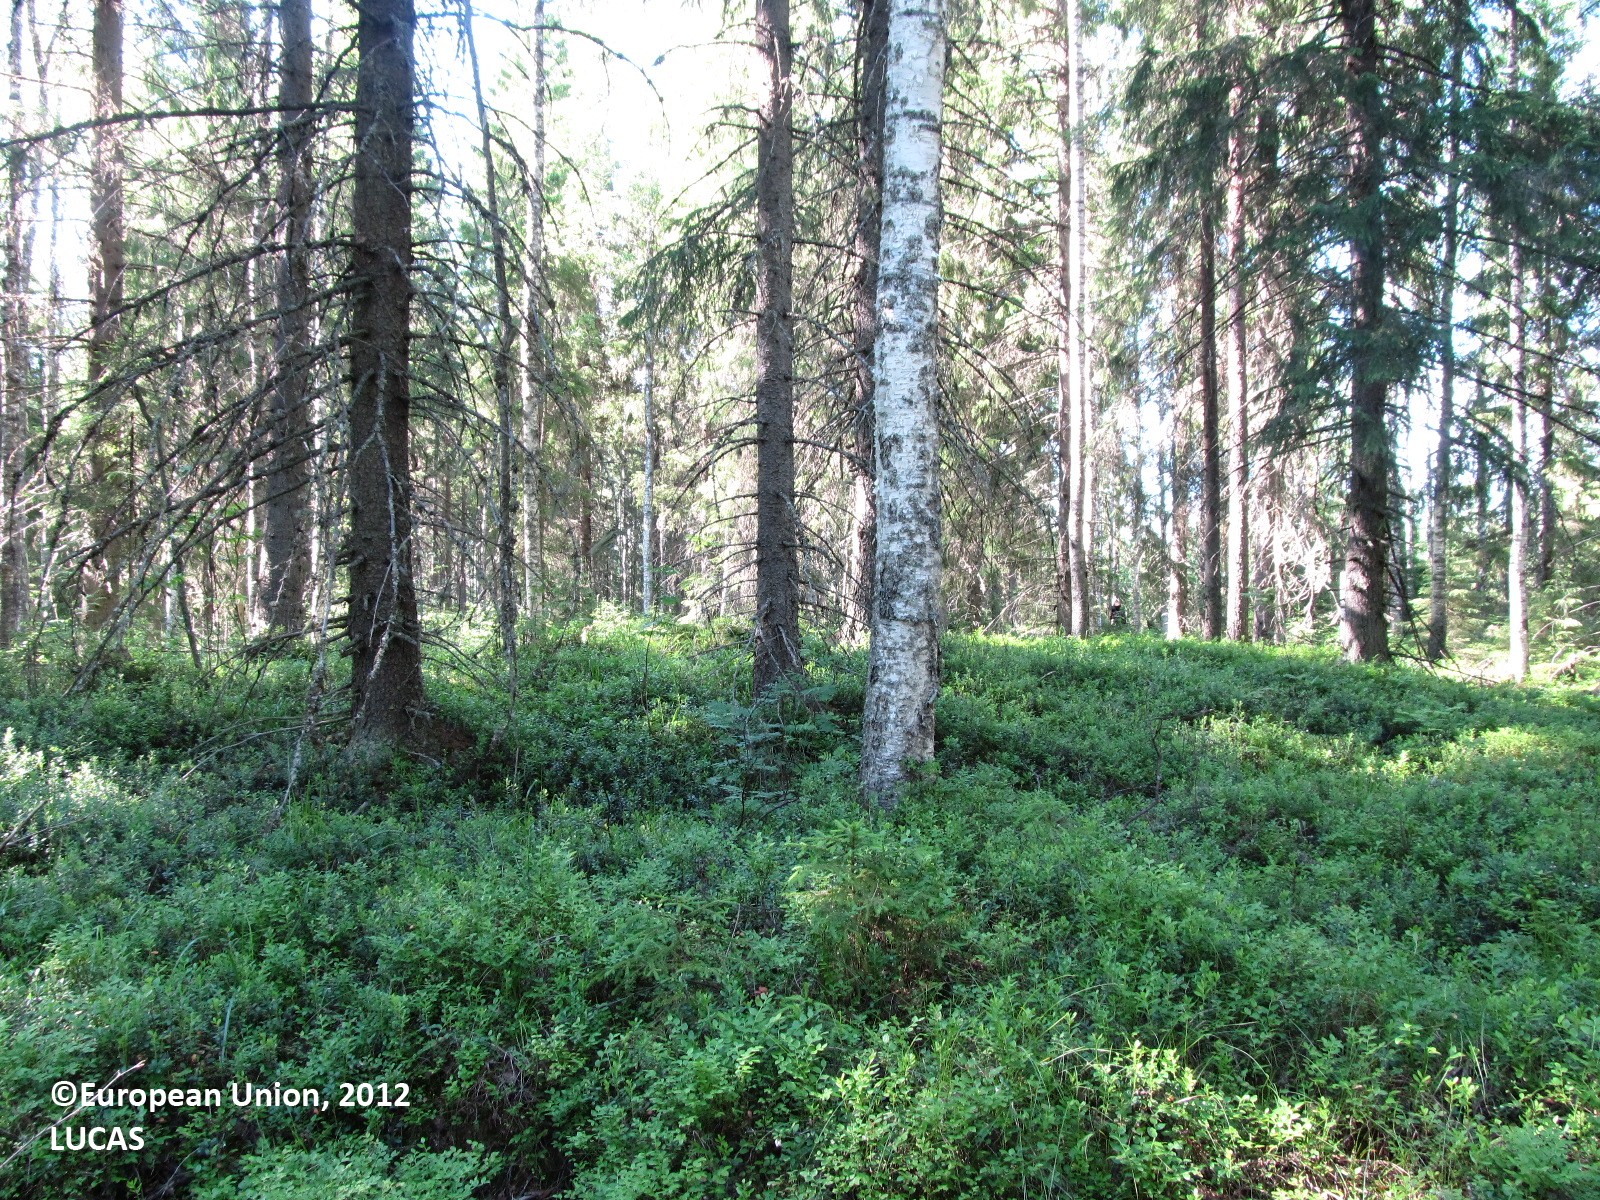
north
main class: Woodland
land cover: Spruce dominated coniferous woodland
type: boreal forest
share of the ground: 50 - 75 %
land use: Forestry
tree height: > 5 m
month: July
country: FI
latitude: 62.5603
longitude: 28.9897
